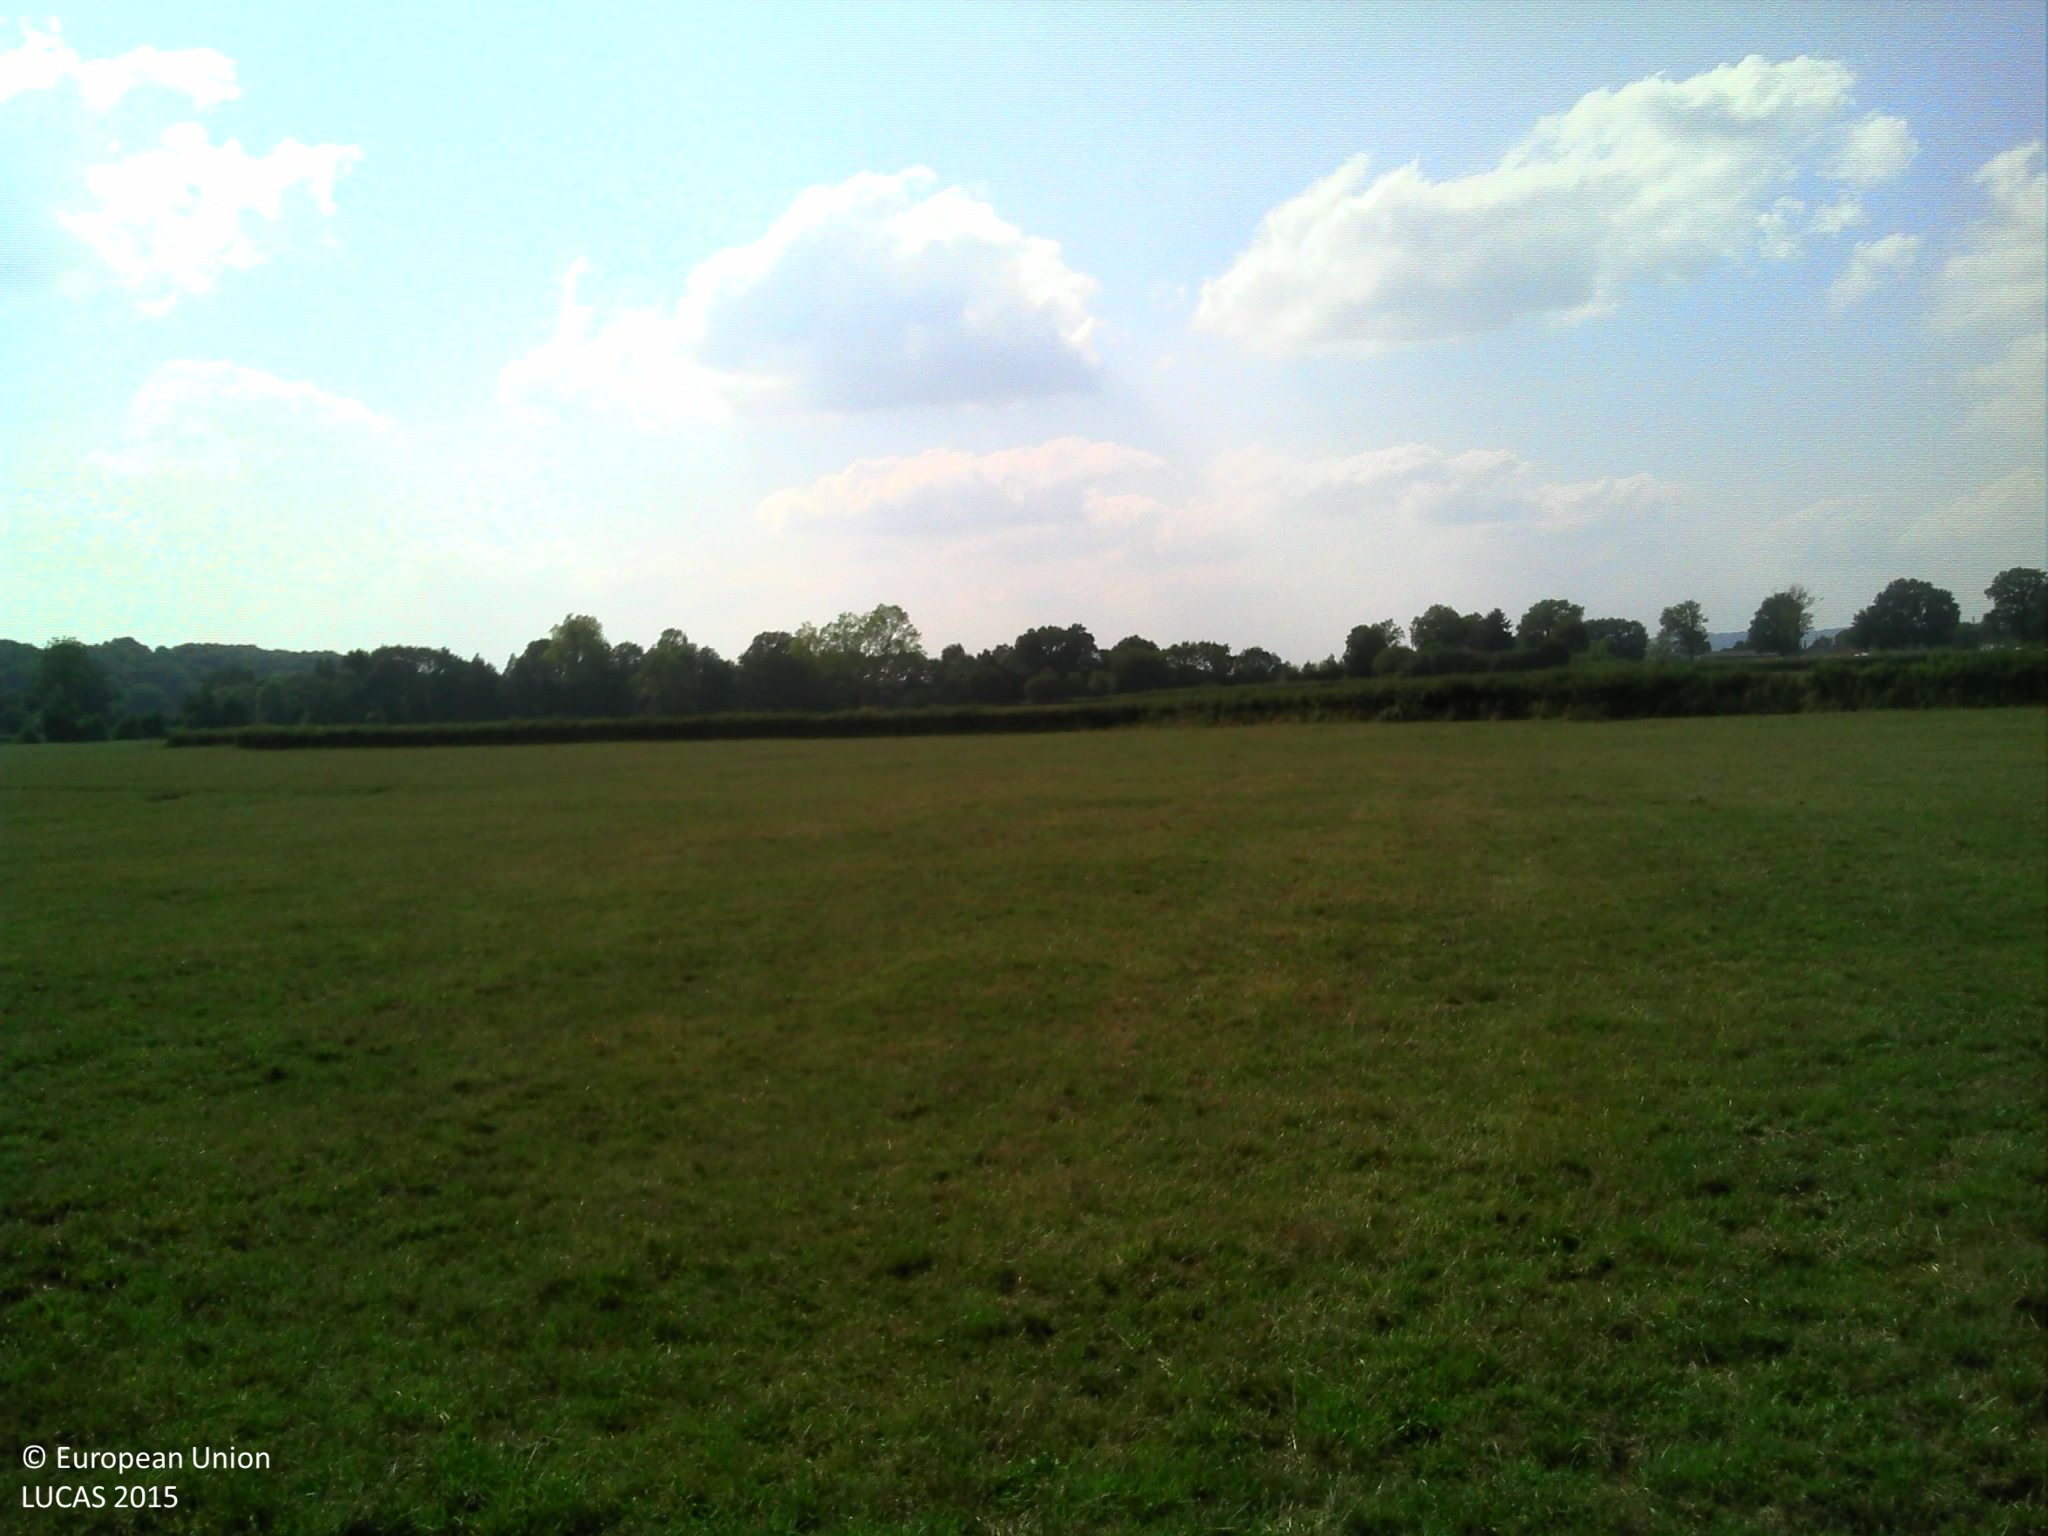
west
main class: Grassland
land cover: Grassland without tree/shrub cover
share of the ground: > 75 %
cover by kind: herbaceous plants 100 %
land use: Agriculture (excluding fallow land and kitchen gardens)
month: August
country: FR
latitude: 47.0352
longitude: 4.4070
